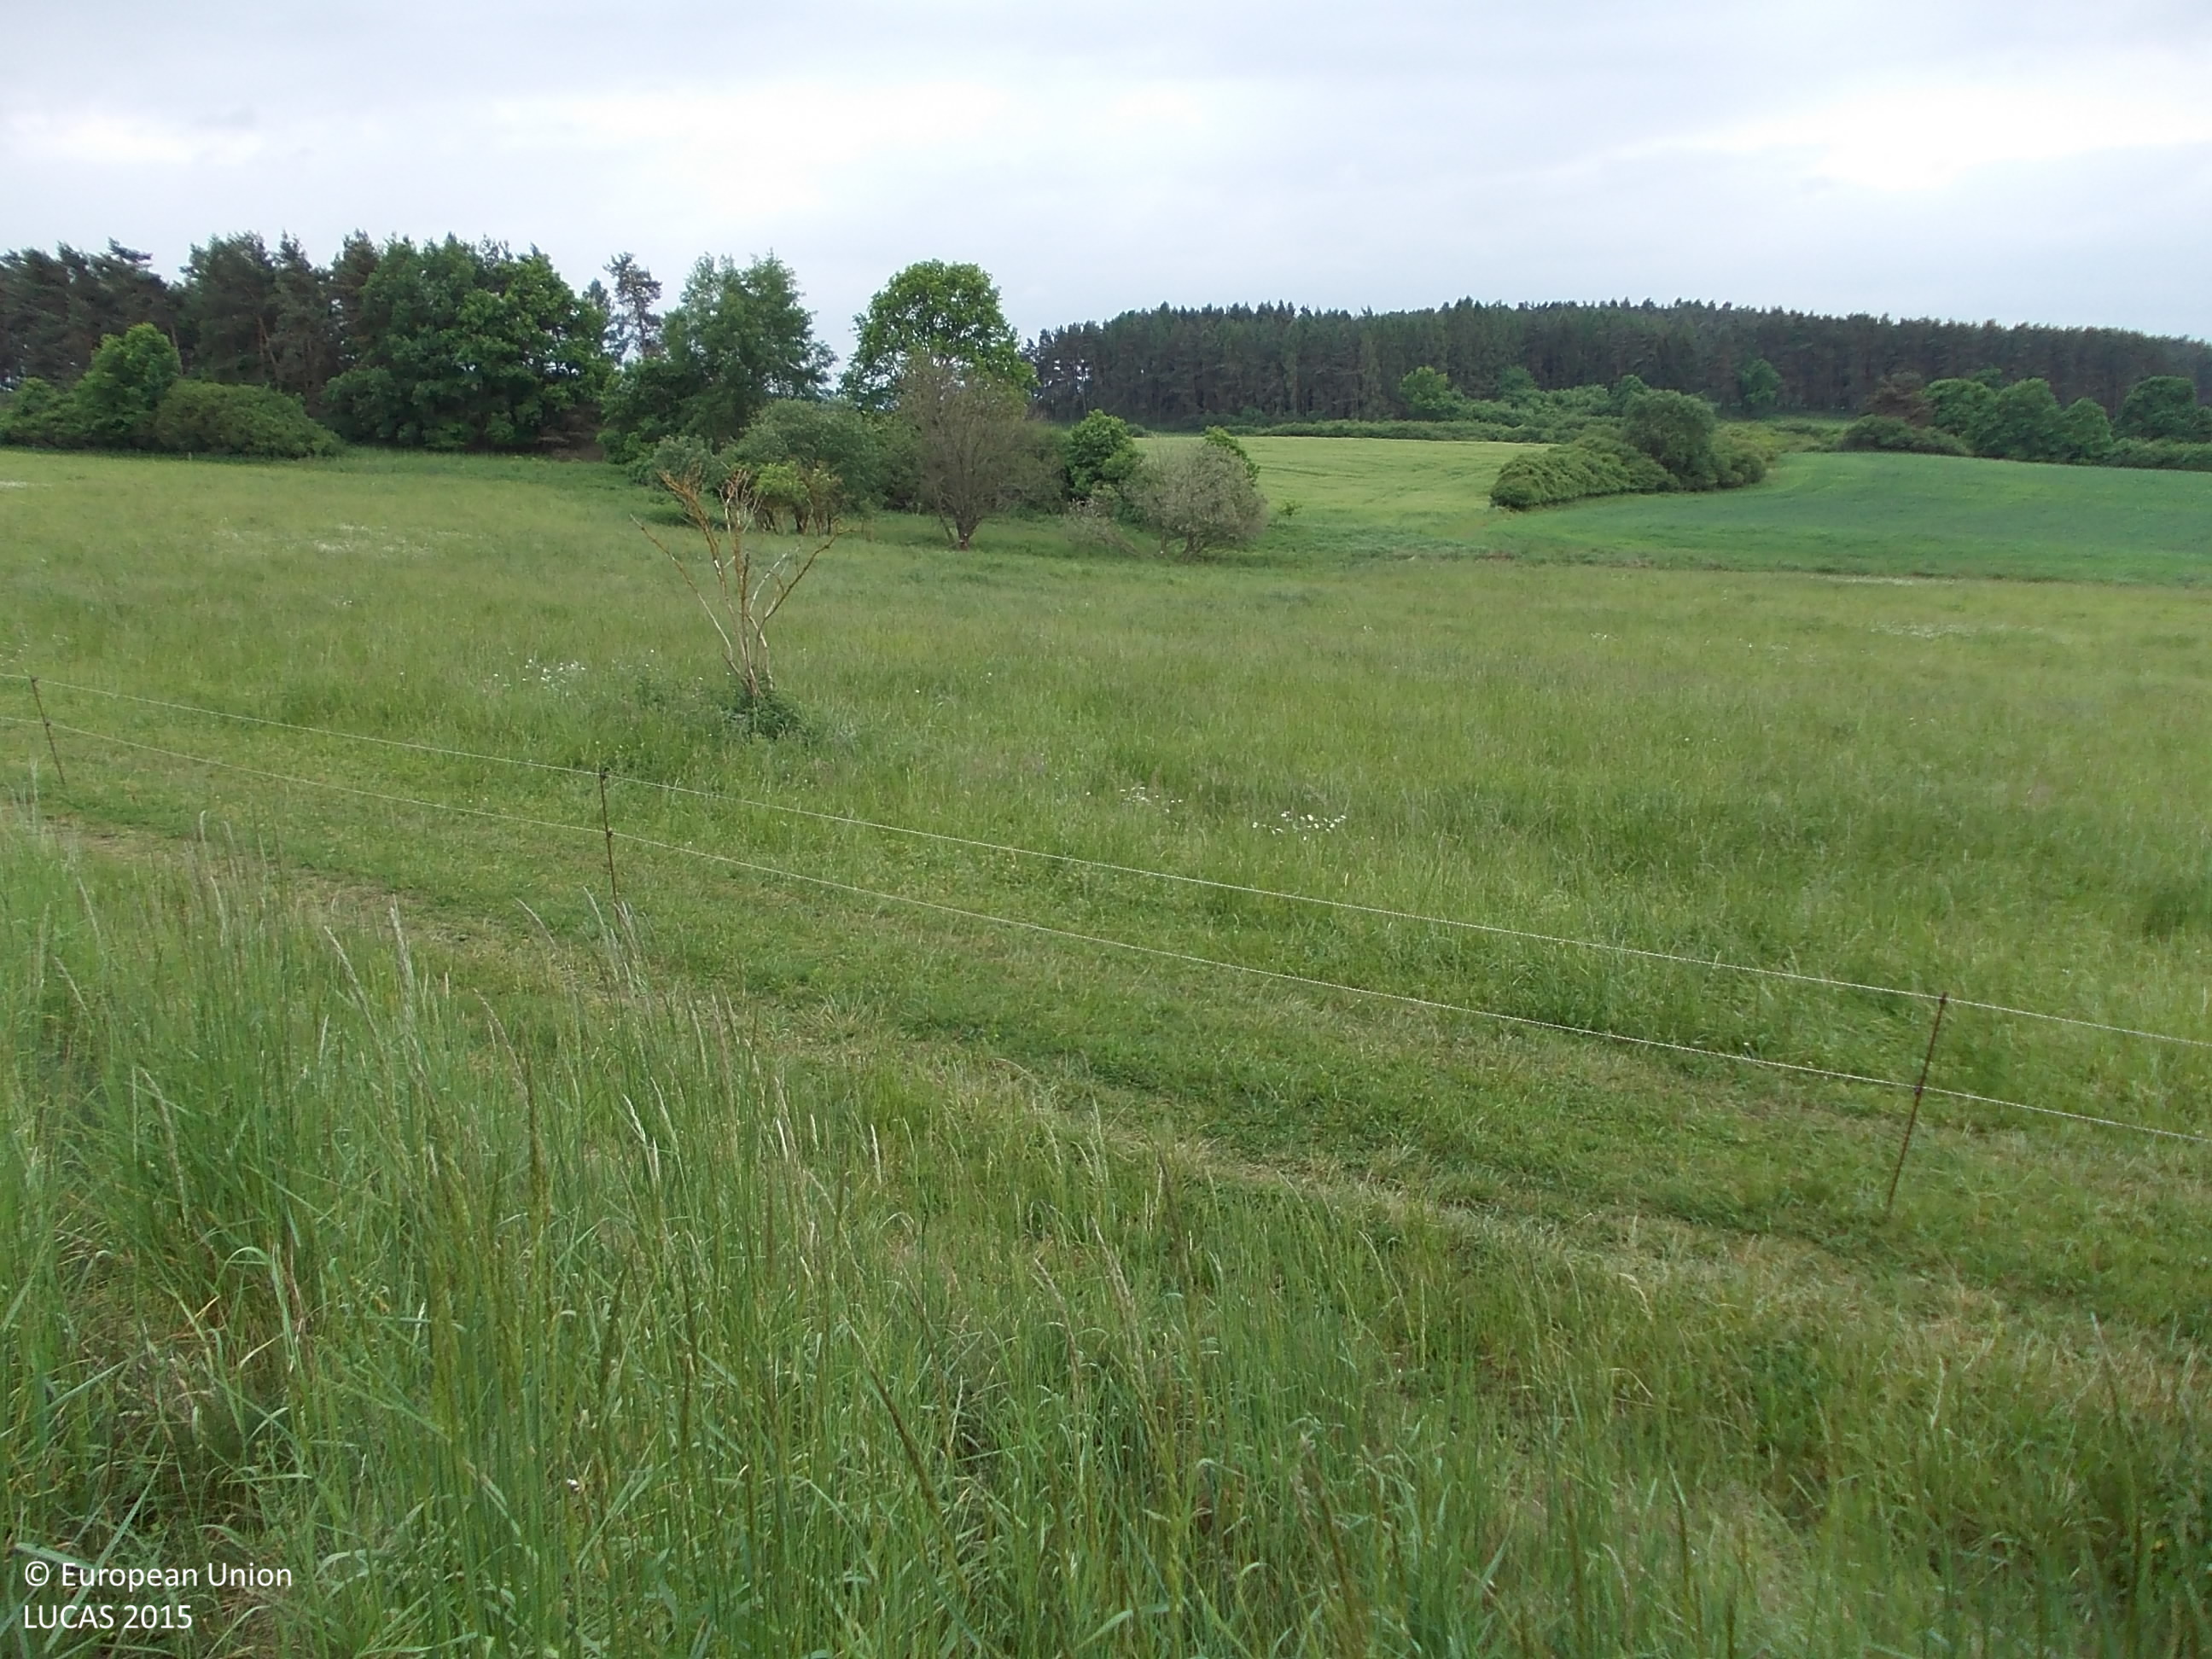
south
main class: Grassland
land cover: Grassland without tree/shrub cover
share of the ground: > 75 %
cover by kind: herbaceous plants 100 %
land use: Semi-natural and natural areas not in use
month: May
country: CZ
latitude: 49.3652
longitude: 13.7872
